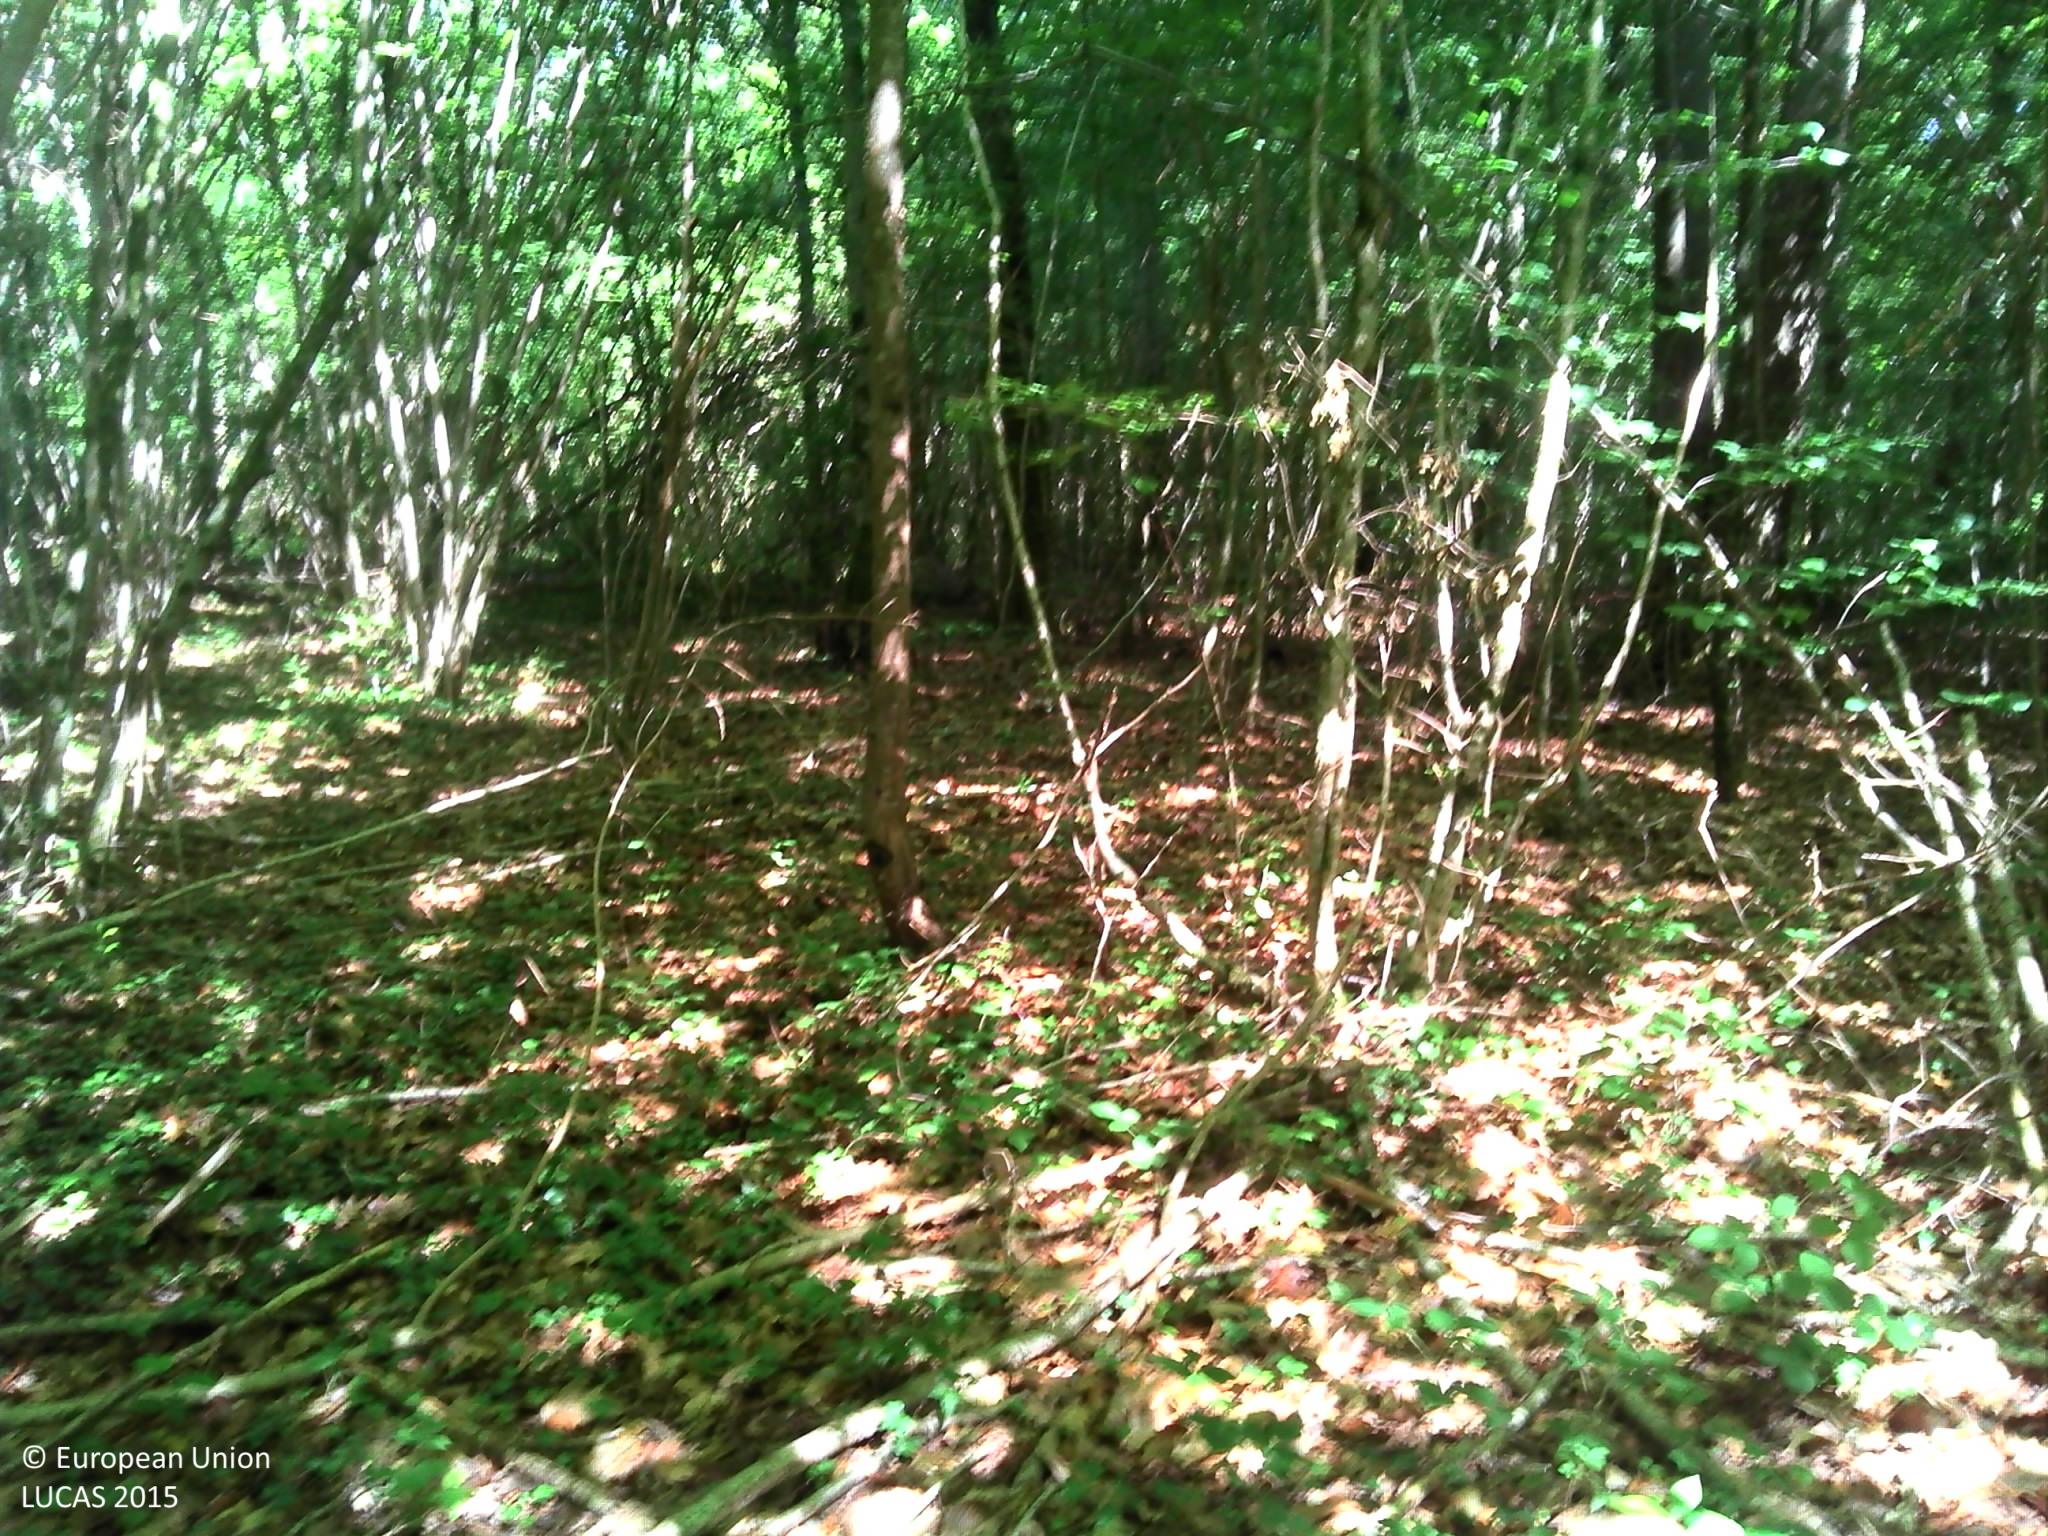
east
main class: Woodland
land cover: Broadleaved woodland
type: beech forest
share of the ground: > 75 %
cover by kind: broadleaved forest trees 90 %, shrubs 5 %, herbaceous plants 5 %
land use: Forestry
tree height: > 5 m
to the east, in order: Broadleaved woodland
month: June
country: FR
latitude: 47.5073
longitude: 6.1378
